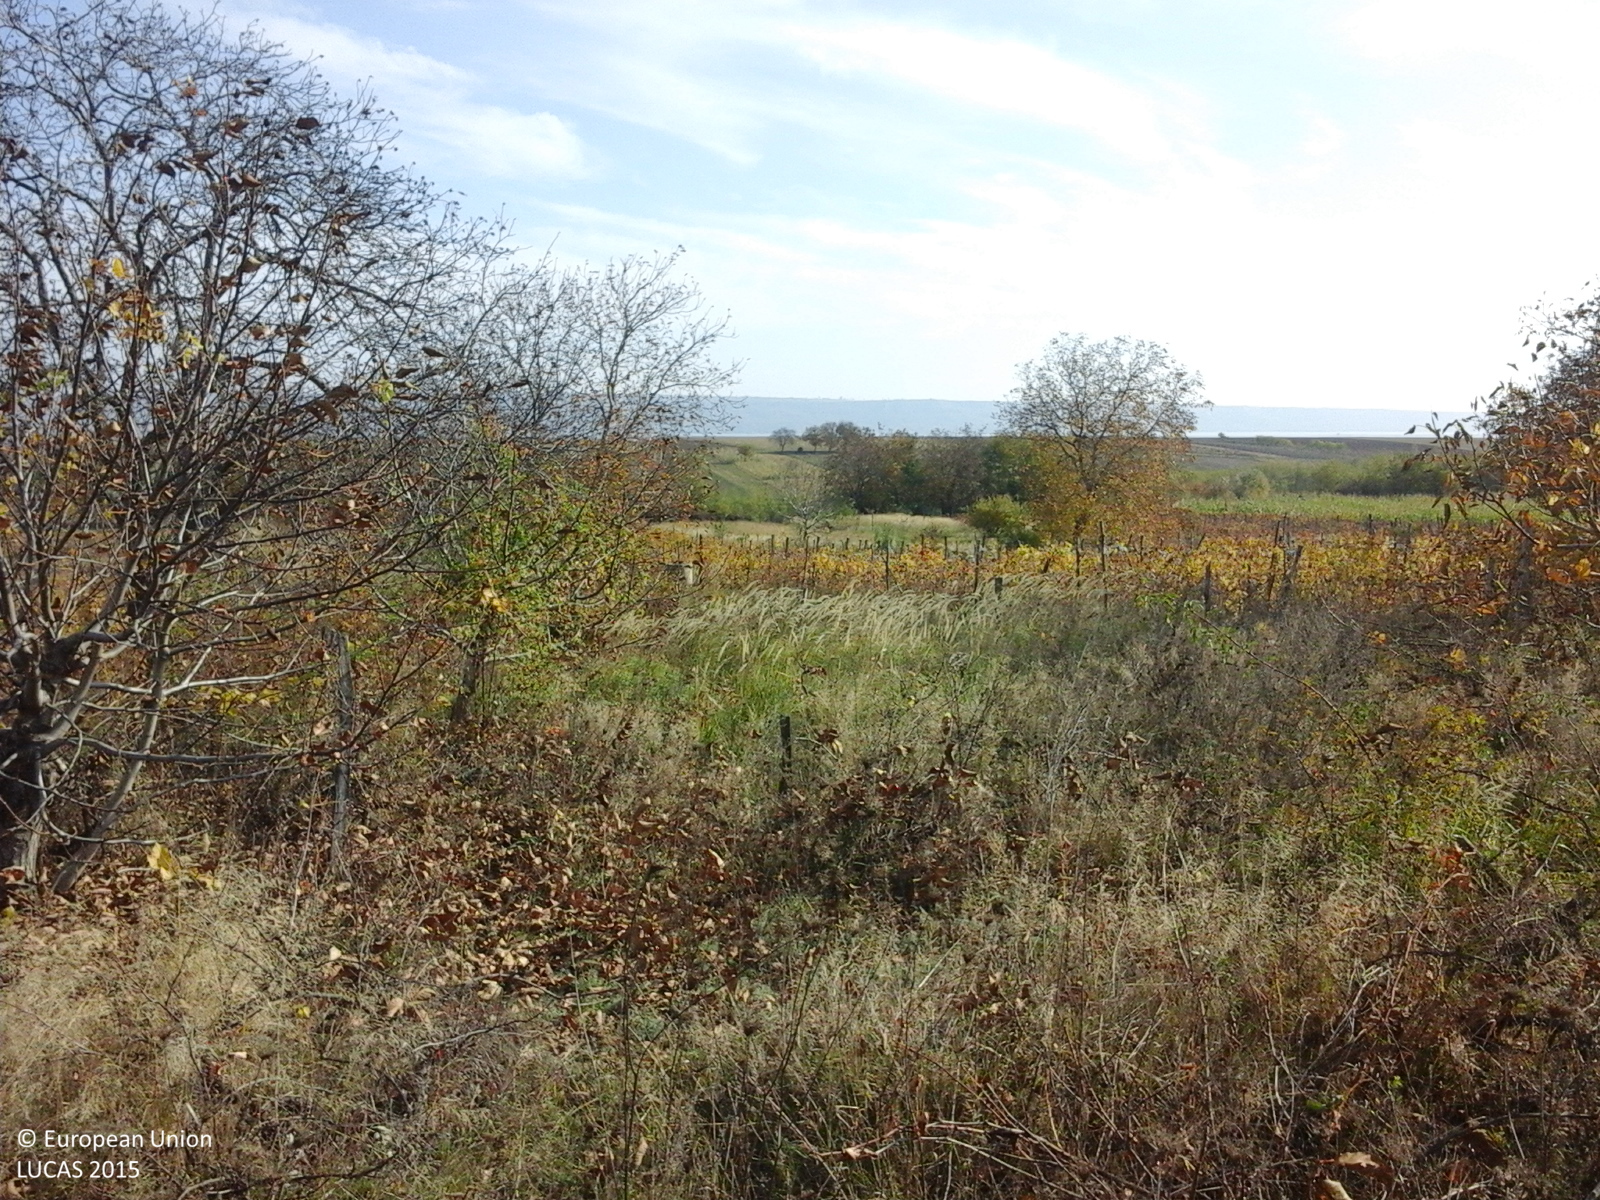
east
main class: Cropland
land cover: Vineyards
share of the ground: > 75 %
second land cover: Spontaneously vegetated surfaces
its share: > 75 %
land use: Agriculture (excluding fallow land and kitchen gardens)
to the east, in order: Vineyards; Spontaneously vegetated surfaces; Grassland with sparse tree/shrub cover; Vineyards; Spontaneously vegetated surfaces; Abandoned hedges; Grass margins; Tracks; Grass margins; Abandoned hedges; Spontaneously vegetated surfaces
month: October
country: RO
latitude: 45.9874
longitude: 27.1231
